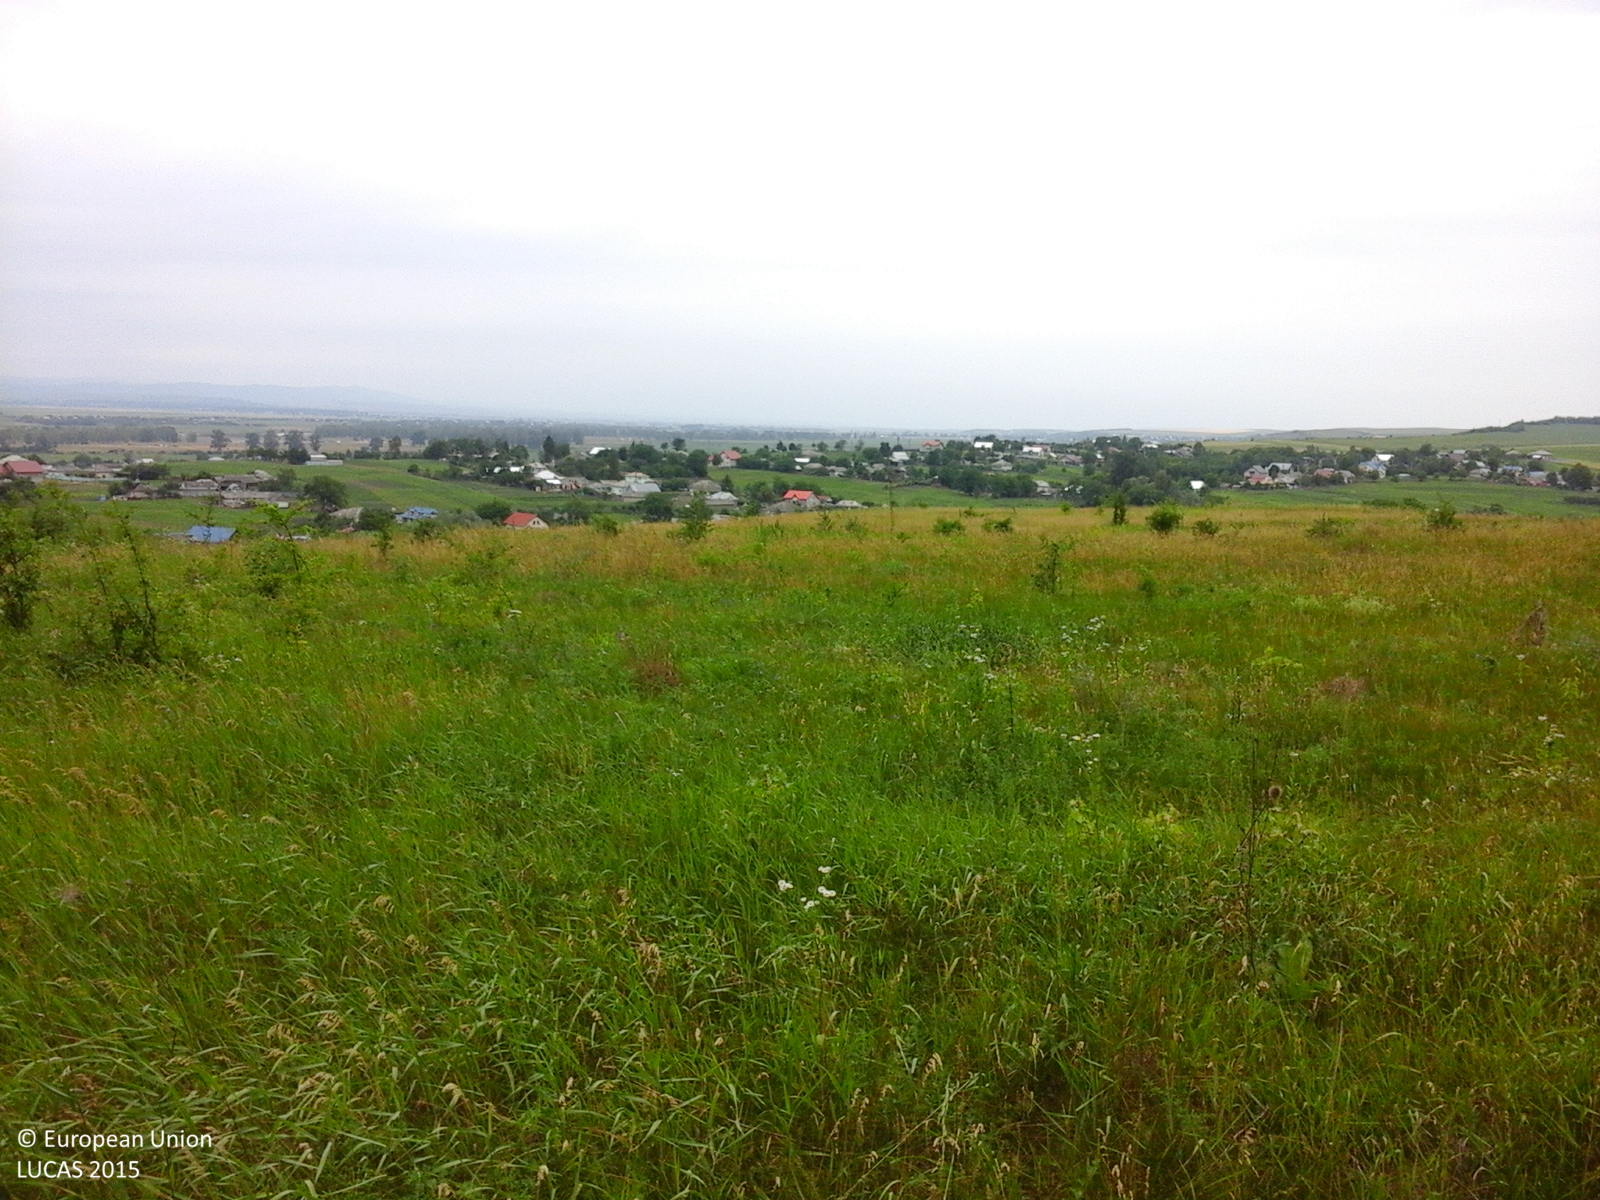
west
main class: Grassland
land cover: Grassland without tree/shrub cover
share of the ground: > 75 %
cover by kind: herbaceous plants 100 %
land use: Agriculture (excluding fallow land and kitchen gardens)
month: June
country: RO
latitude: 47.2054
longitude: 26.6323
